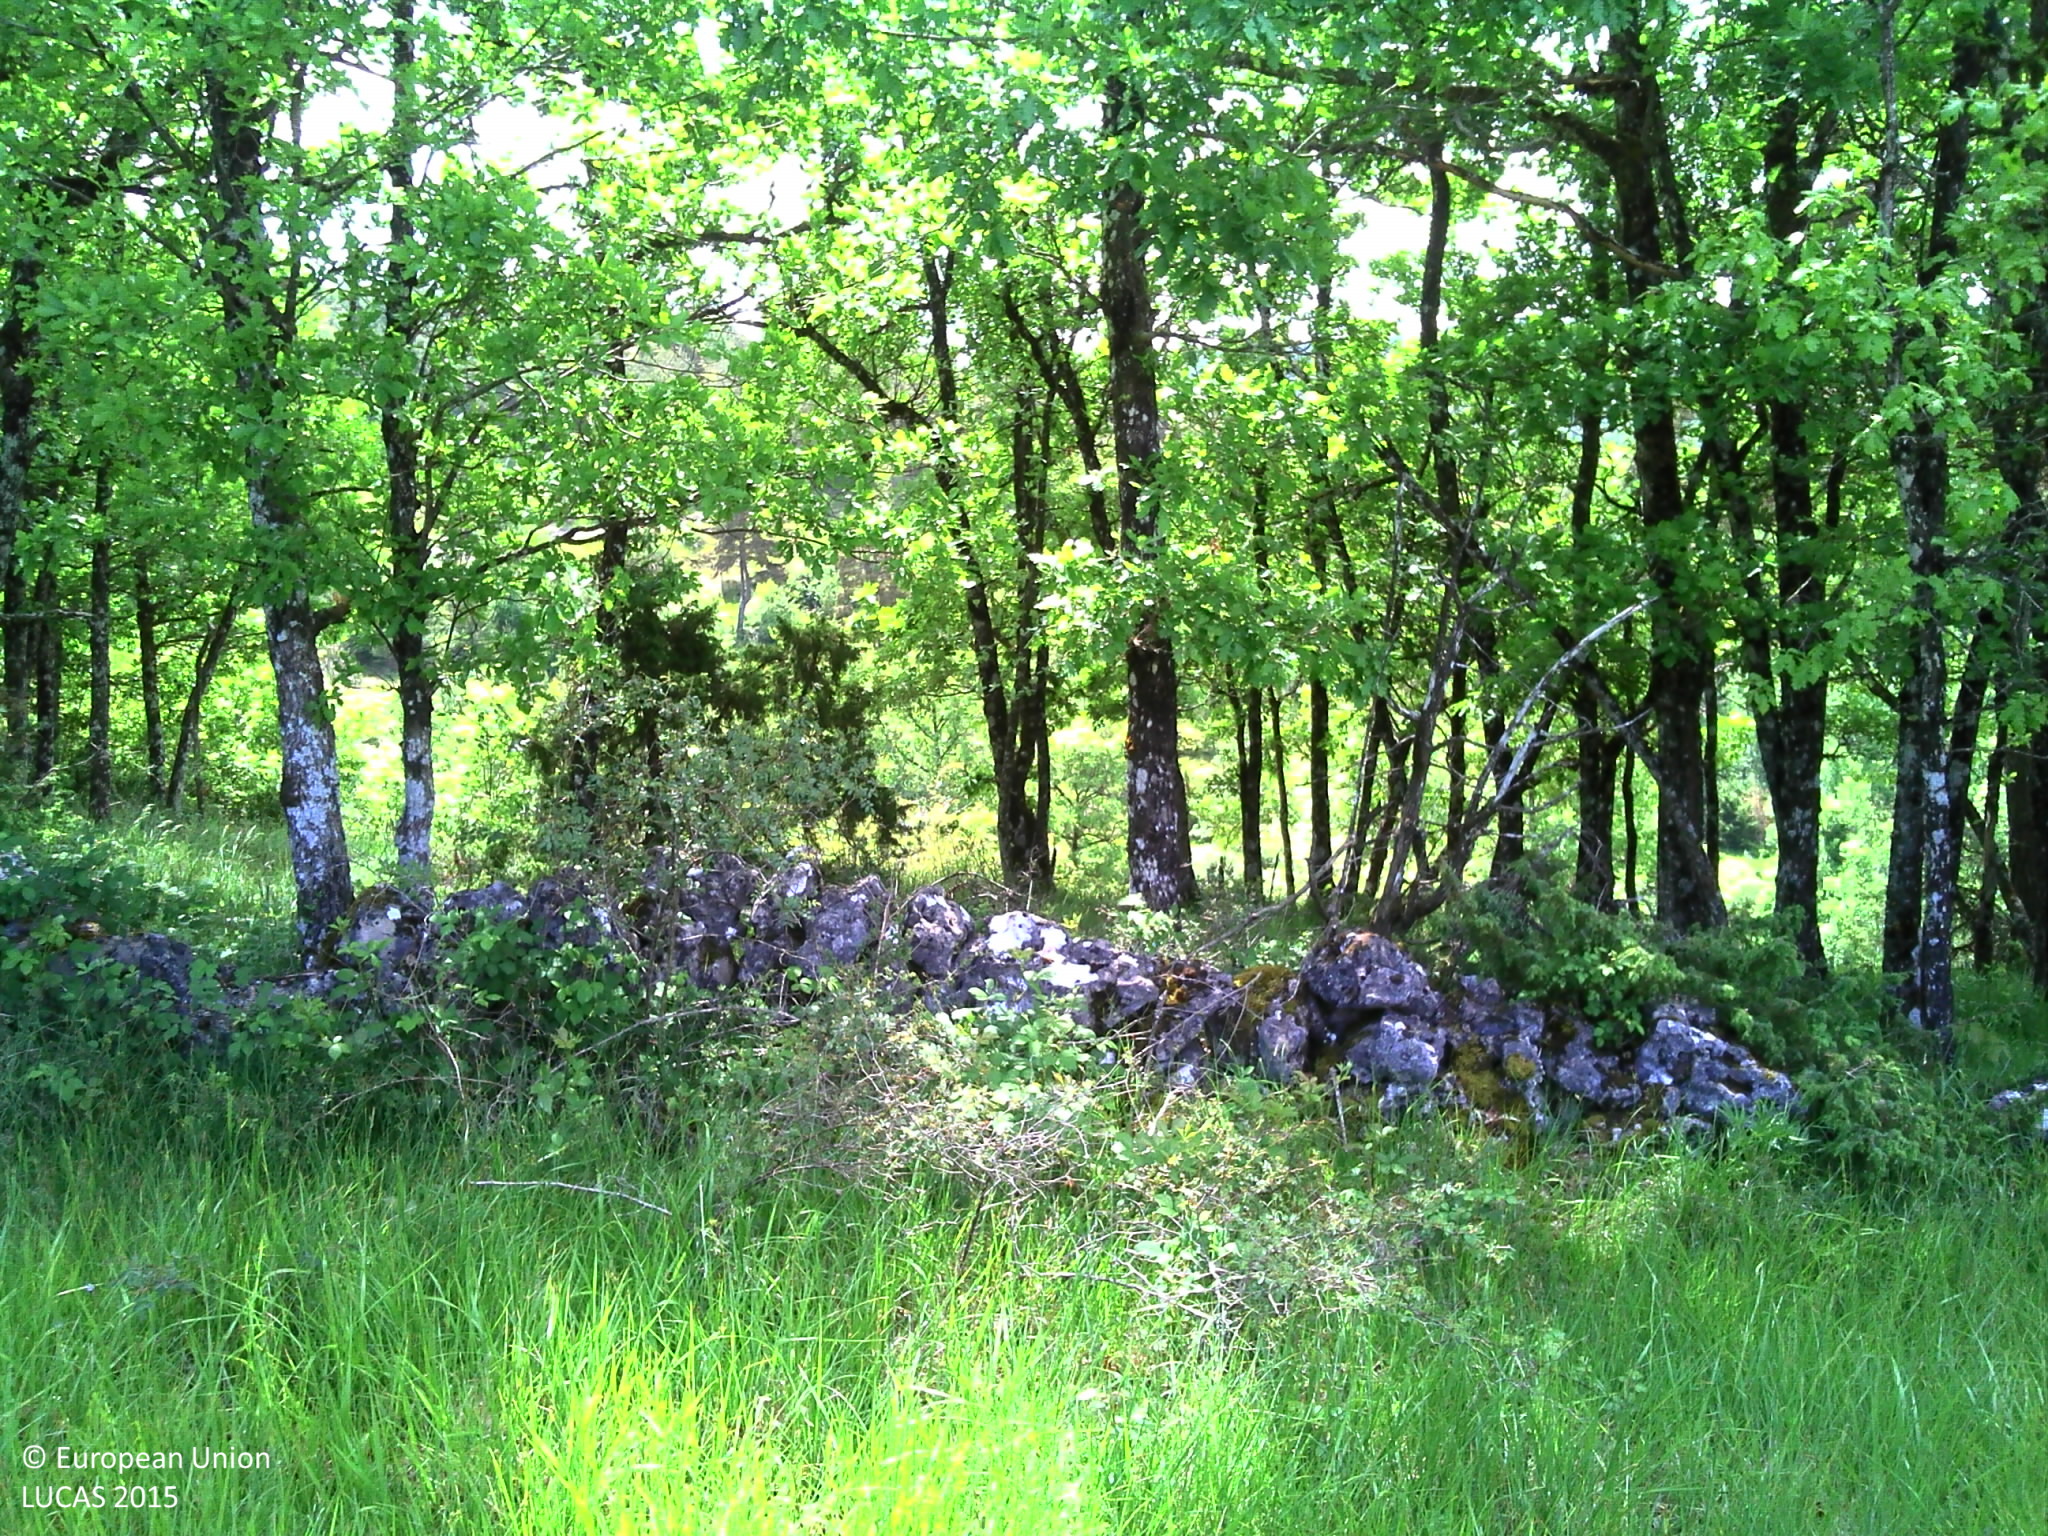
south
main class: Grassland
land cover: Grassland with sparse tree/shrub cover
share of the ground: > 75 %
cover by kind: herbaceous plants 90 %, broadleaved forest trees 5 %, shrubs 5 %
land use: Agriculture (excluding fallow land and kitchen gardens)
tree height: < 5 m
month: May
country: FR
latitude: 44.3880
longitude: 3.0377
